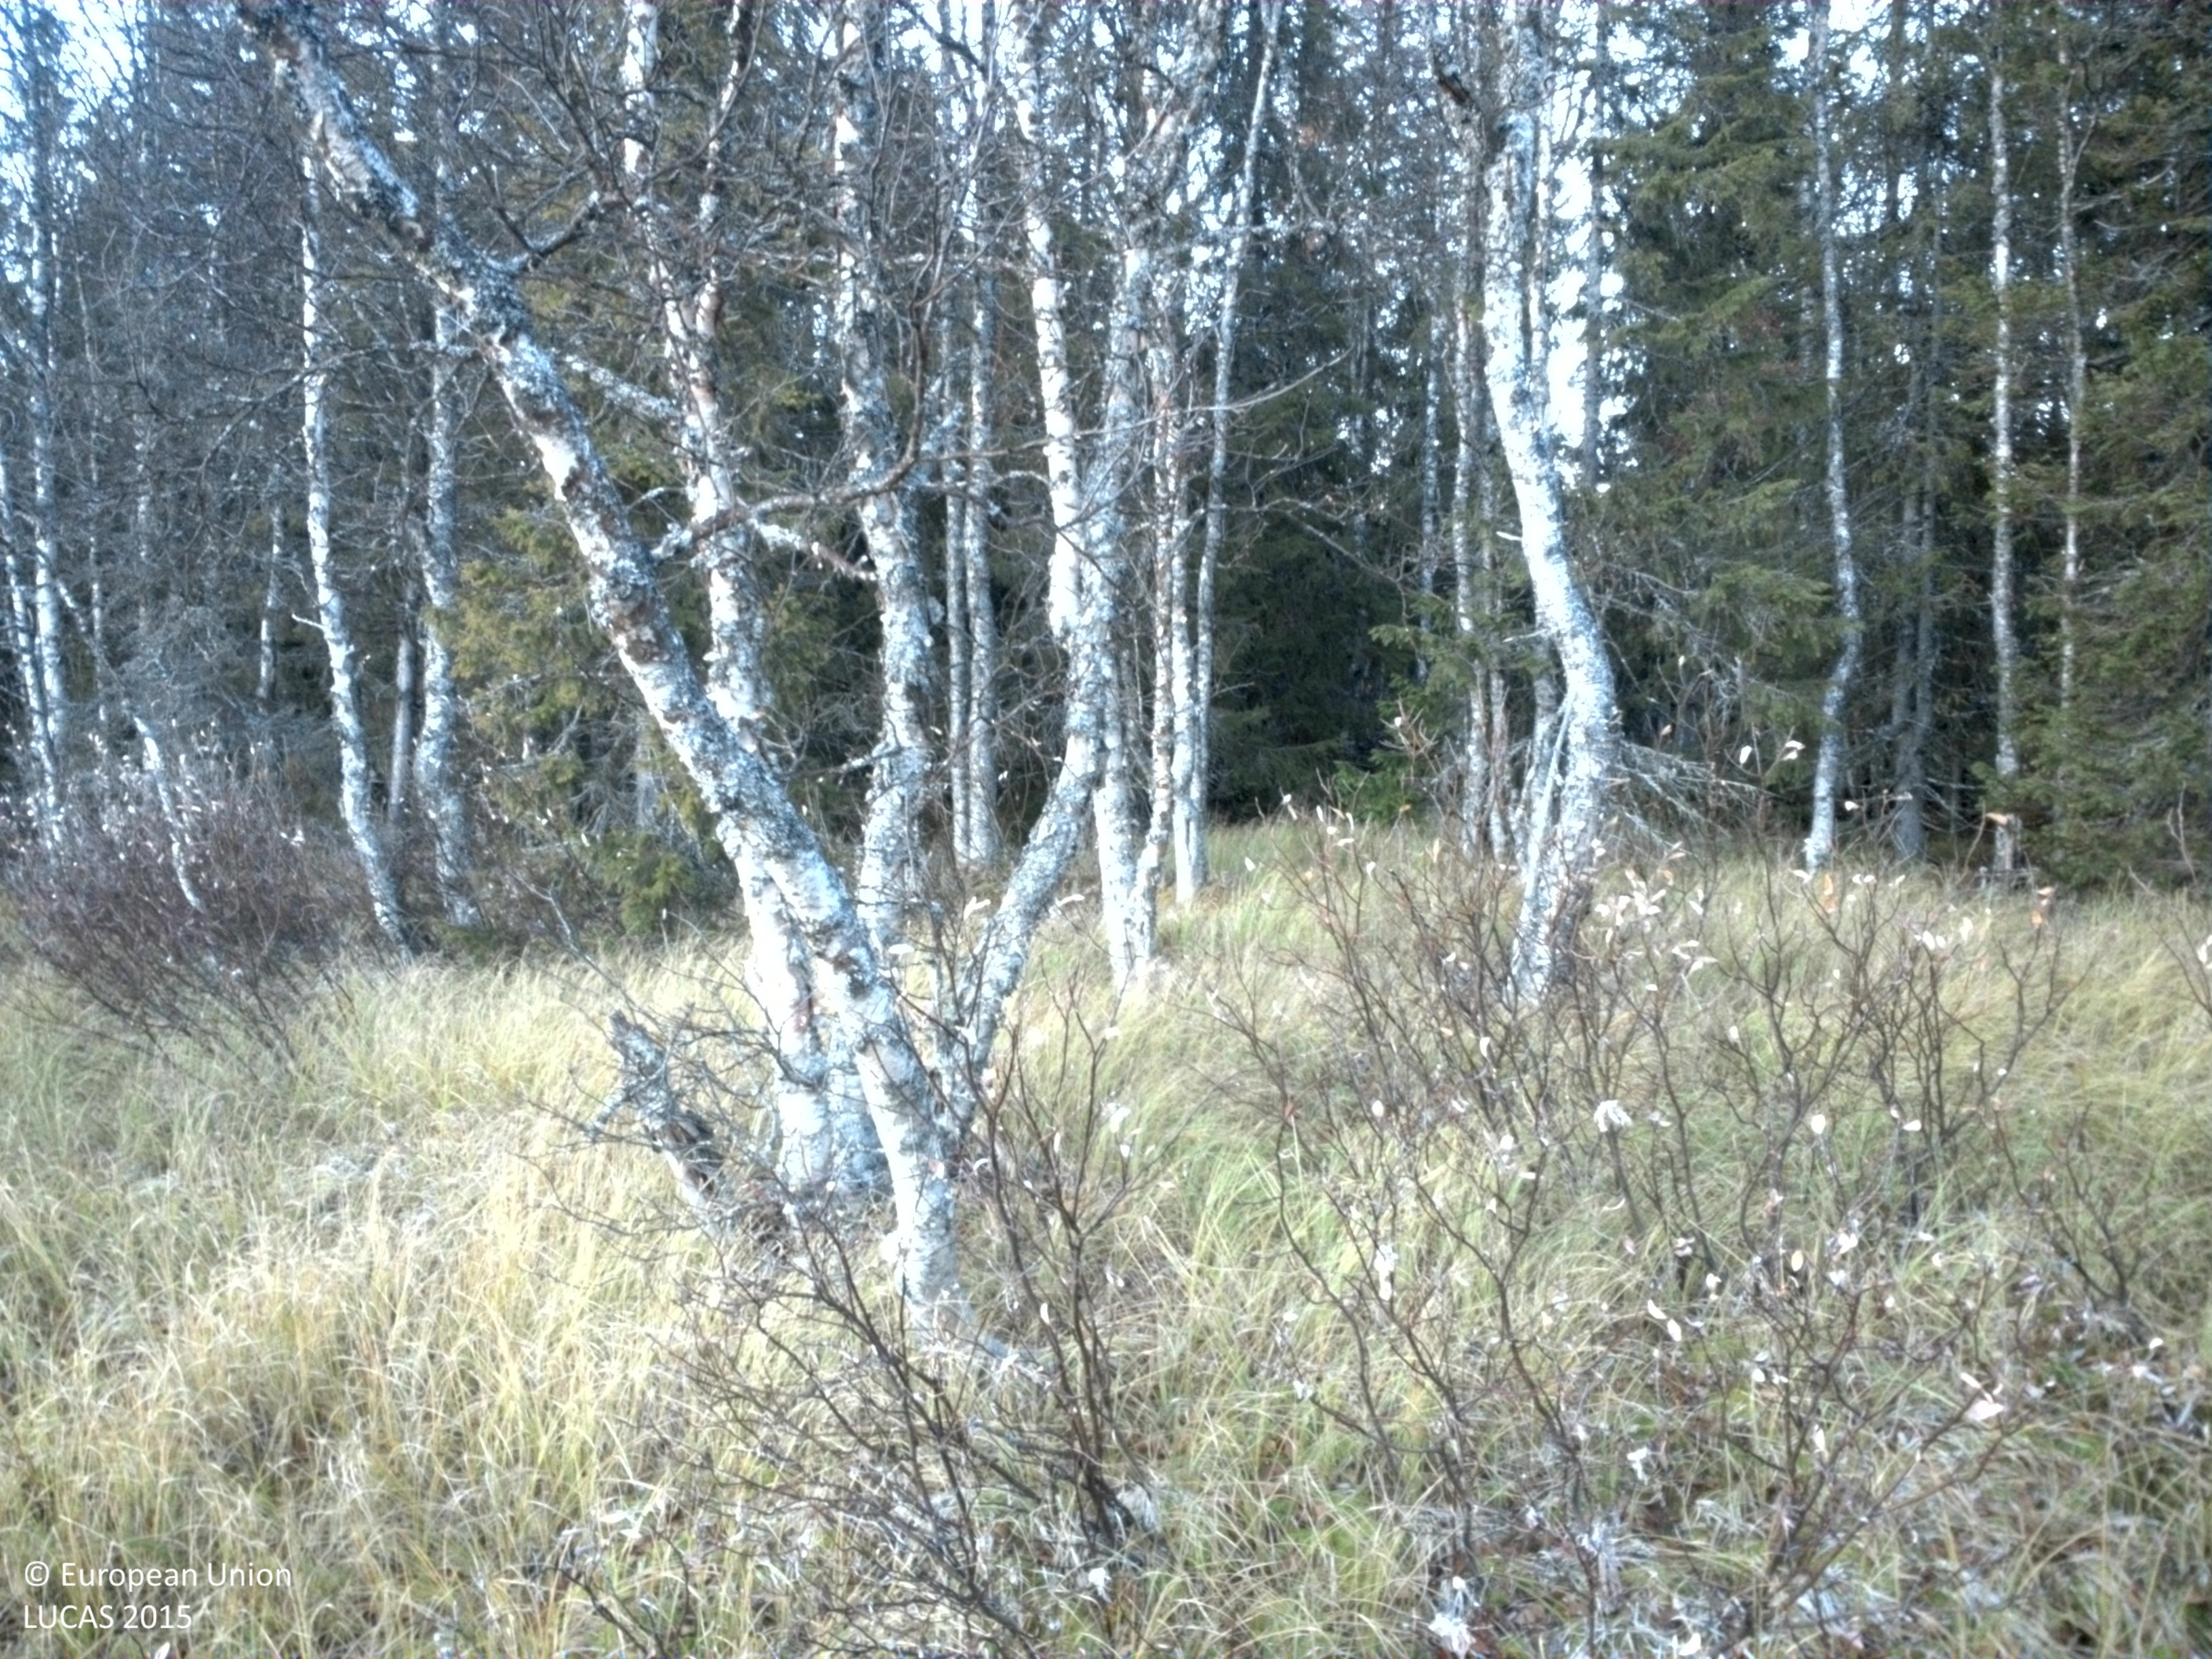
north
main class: Shrubland
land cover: Shrubland without tree cover
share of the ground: 25 - 50 %
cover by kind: herbaceous plants 40 %, shrubs 35 %, lichens and mosses 25 %
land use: Semi-natural and natural areas not in use
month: October
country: SE
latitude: 64.7309
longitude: 17.4610
